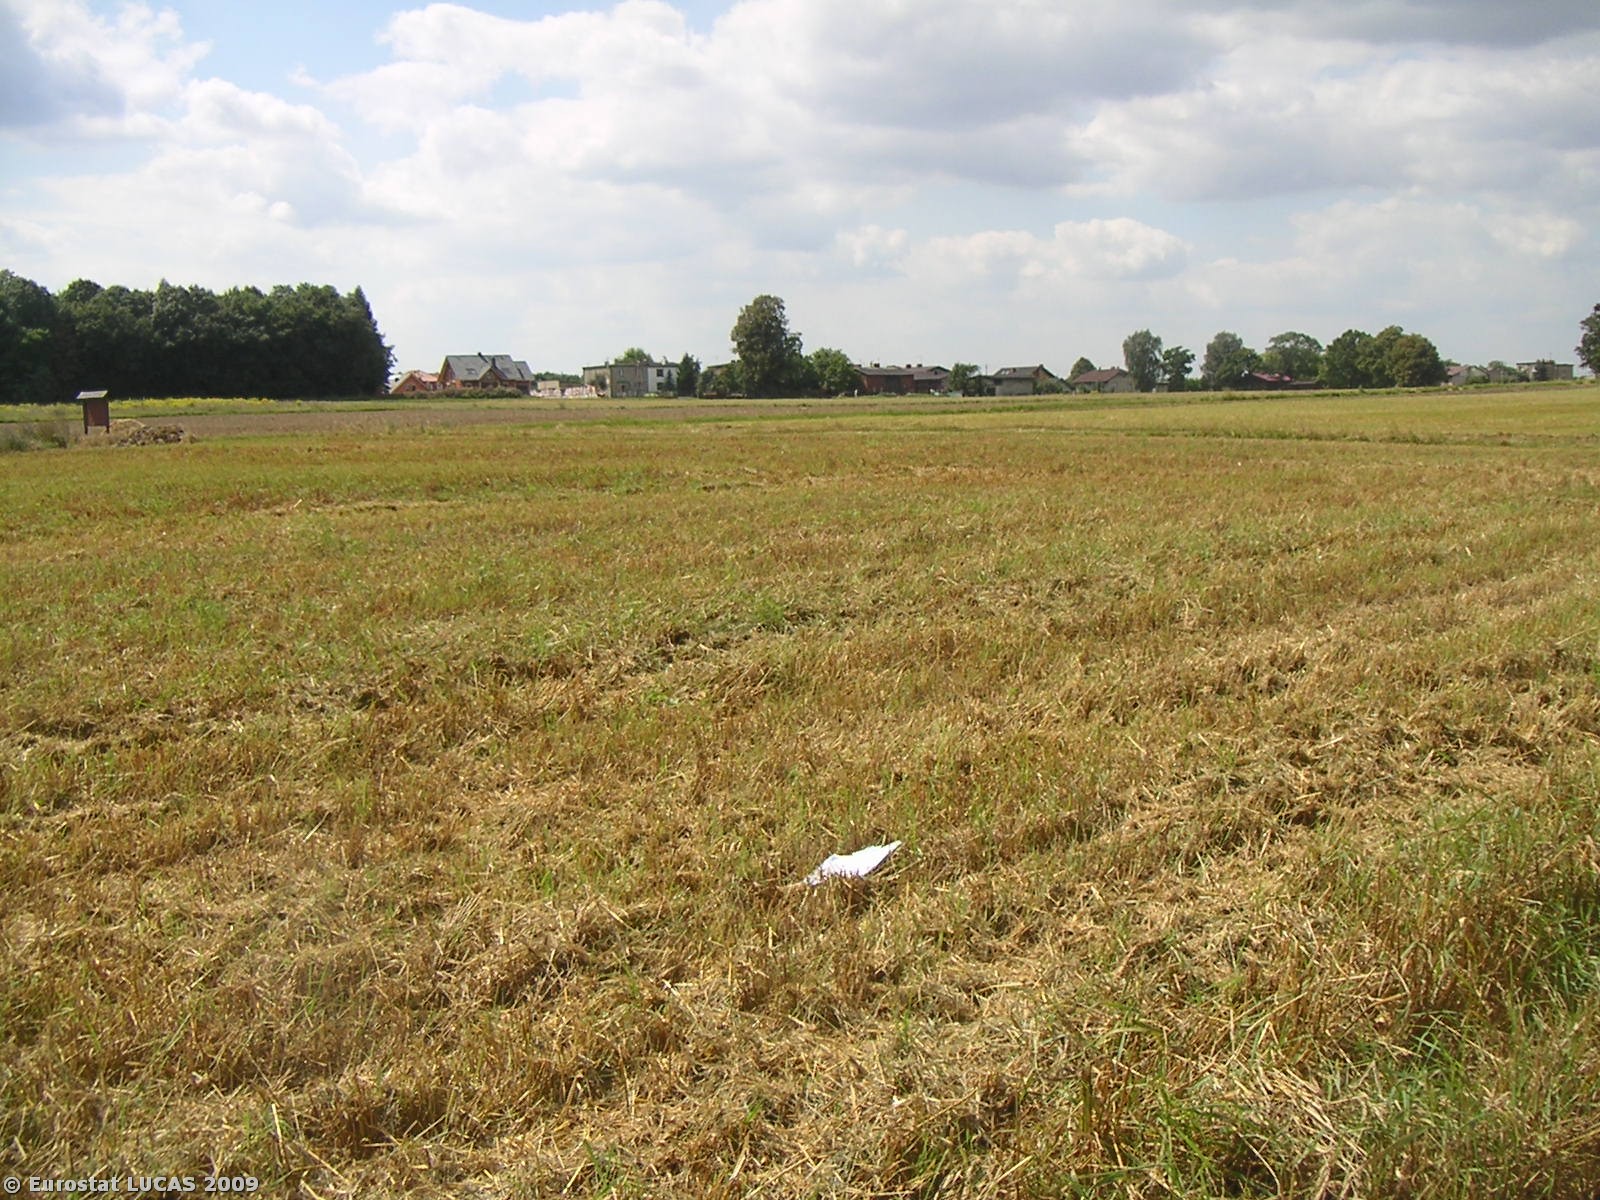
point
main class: Cropland
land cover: Rye
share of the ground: < 10 %
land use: Agriculture (excluding fallow land and kitchen gardens)
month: August
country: PL
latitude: 50.4188
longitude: 18.8463
